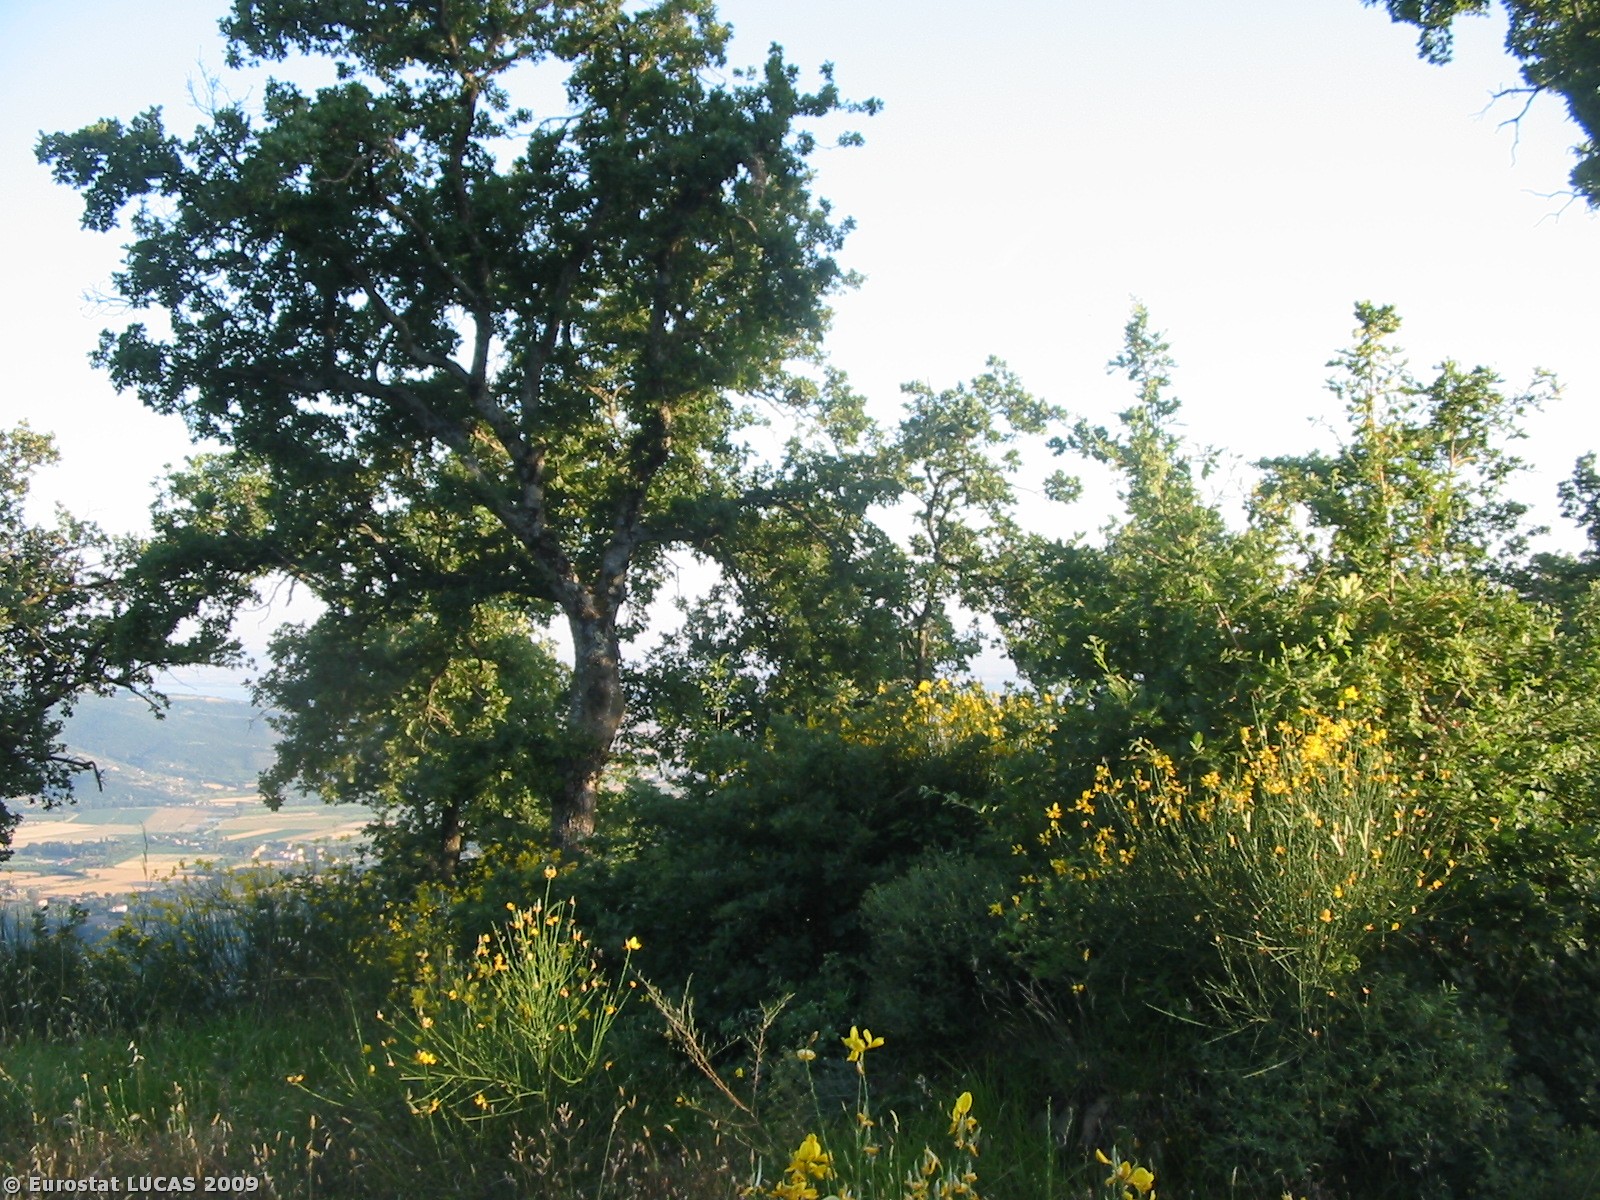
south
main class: Shrubland
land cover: Shrubland with sparse tree cover
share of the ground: > 75 %
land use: Unused
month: June
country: IT
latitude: 43.2844
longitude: 12.0031
